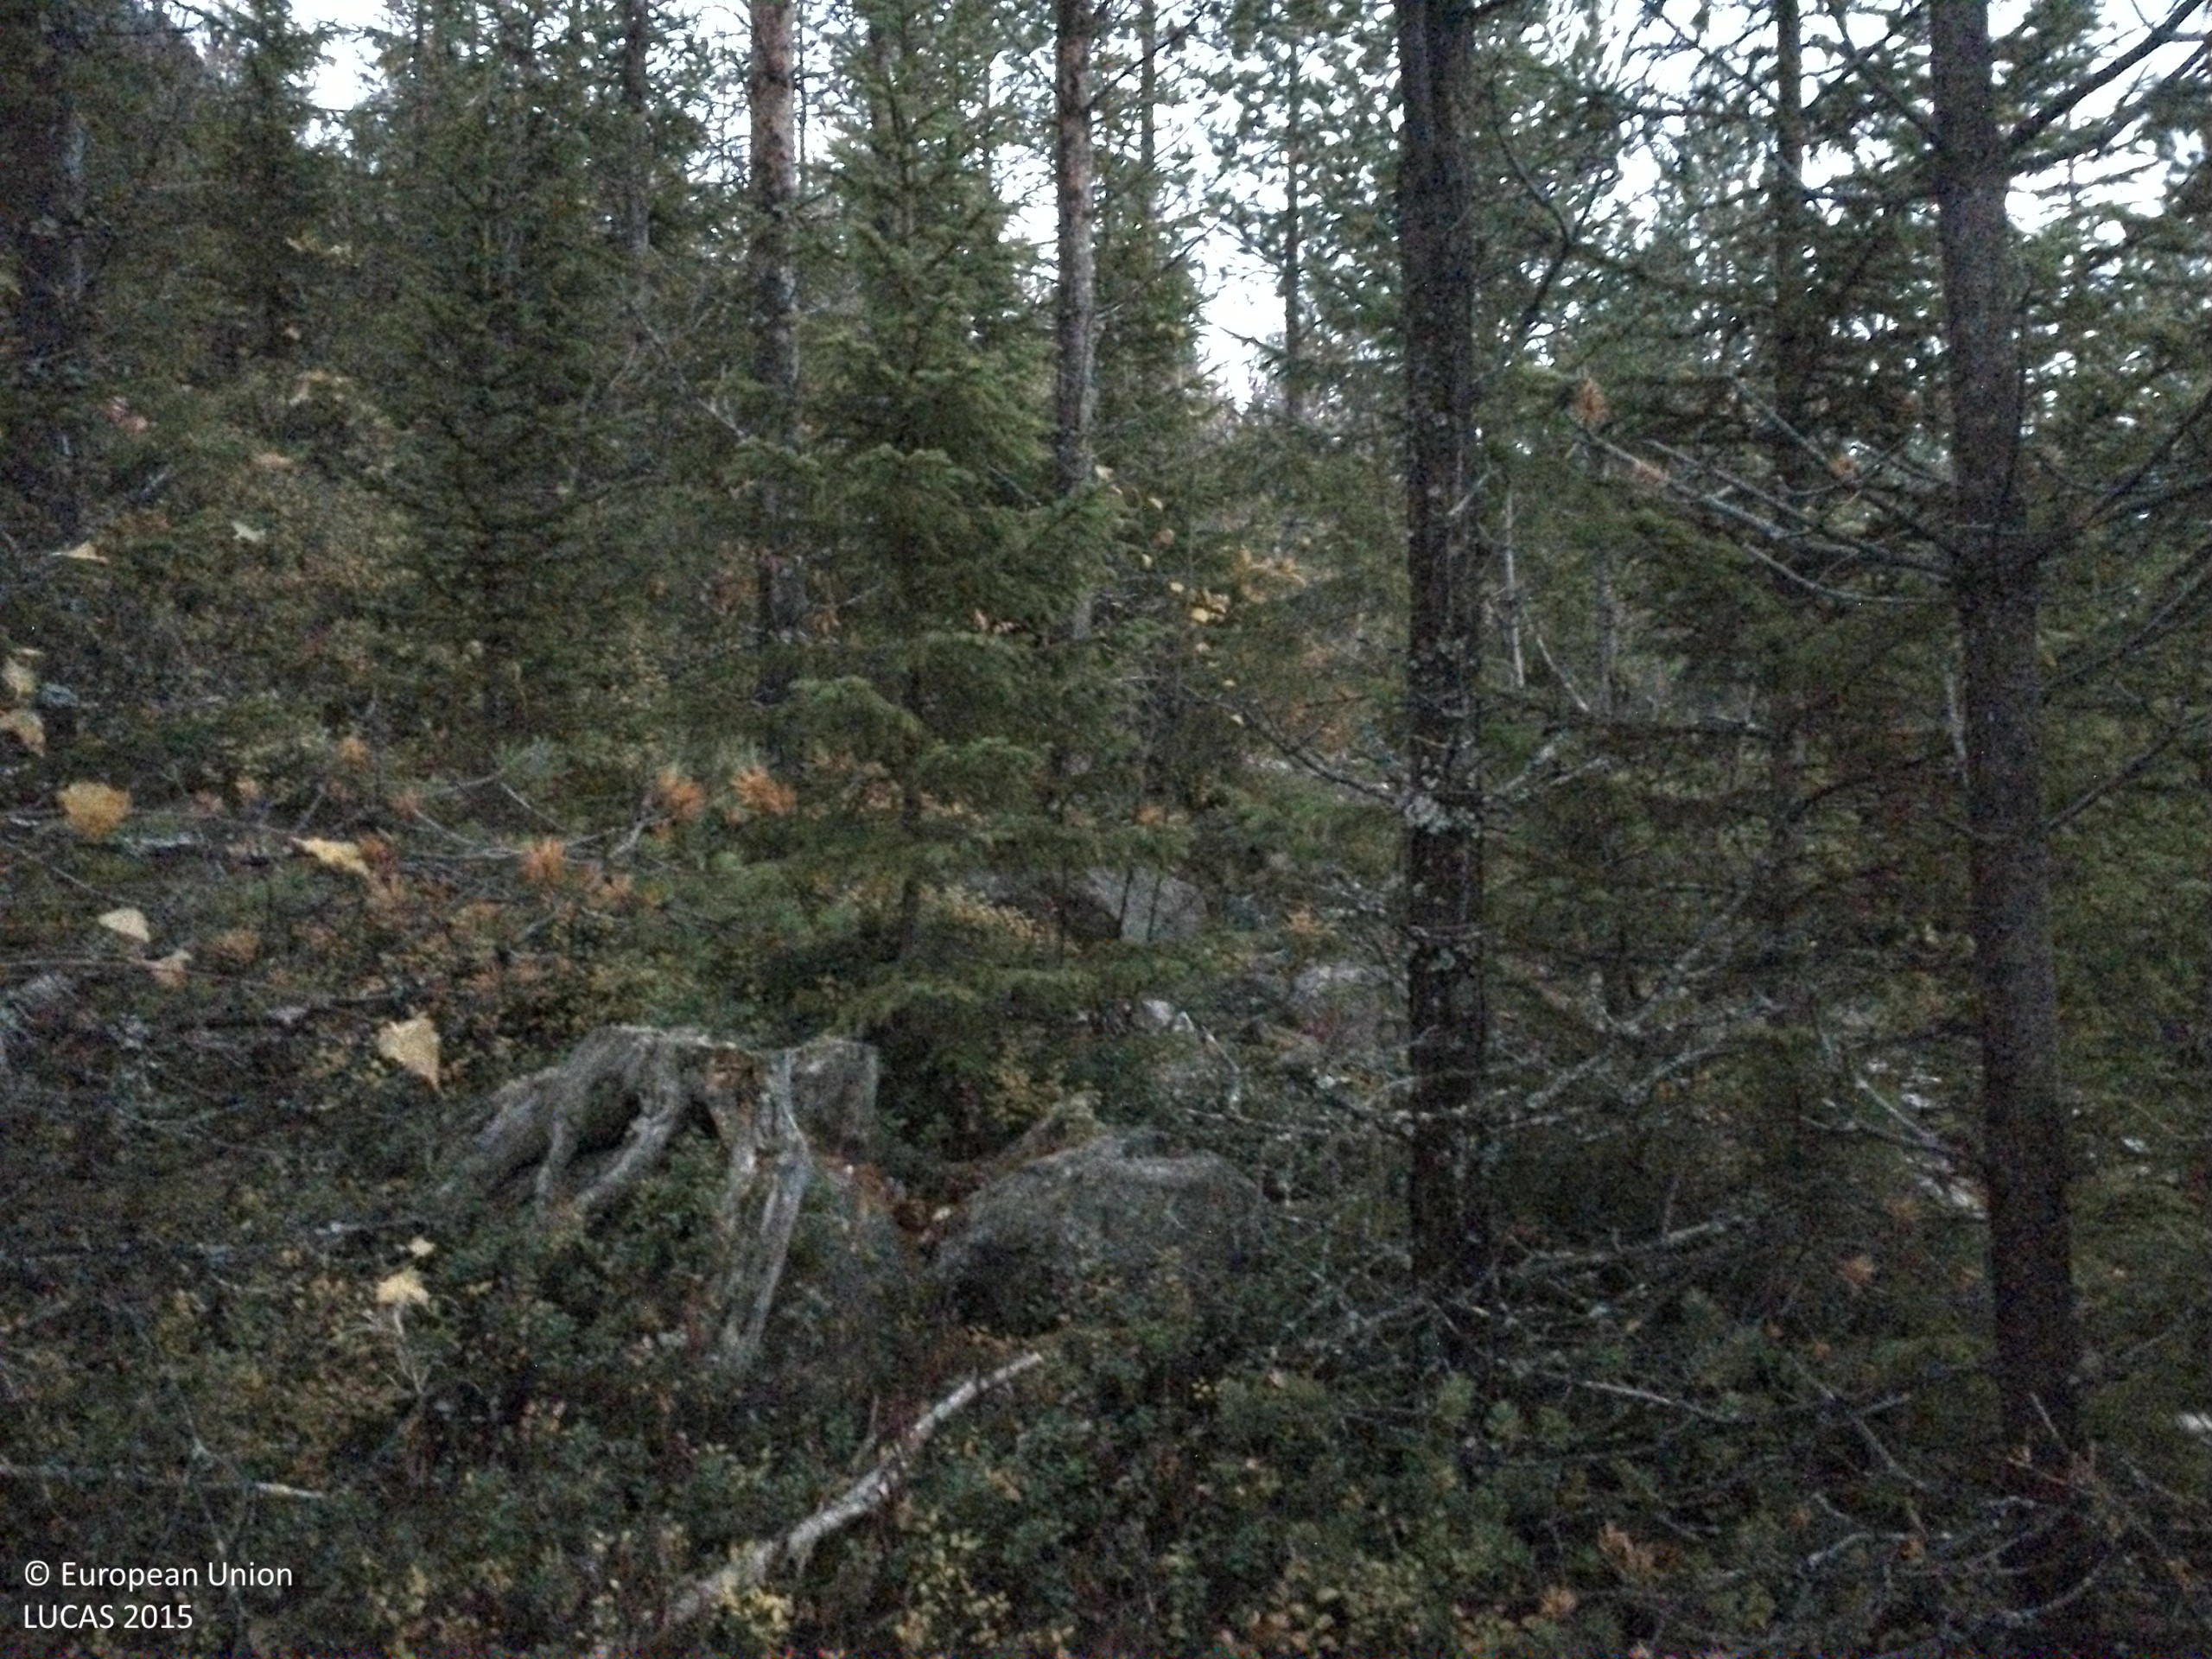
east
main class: Woodland
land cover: Pine dominated coniferous woodland
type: boreal forest
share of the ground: 25 - 50 %
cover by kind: coniferous forest trees 35 %, shrubs 25 %, consolidated bare surface 20 %, lichens and mosses 15 %, broadleaved forest trees 5 %
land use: Forestry
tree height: > 5 m
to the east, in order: Pine dominated coniferous woodland; Pine dominated mixed woodland; Pine dominated coniferous woodland
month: October
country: SE
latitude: 64.3308
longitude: 15.2066
